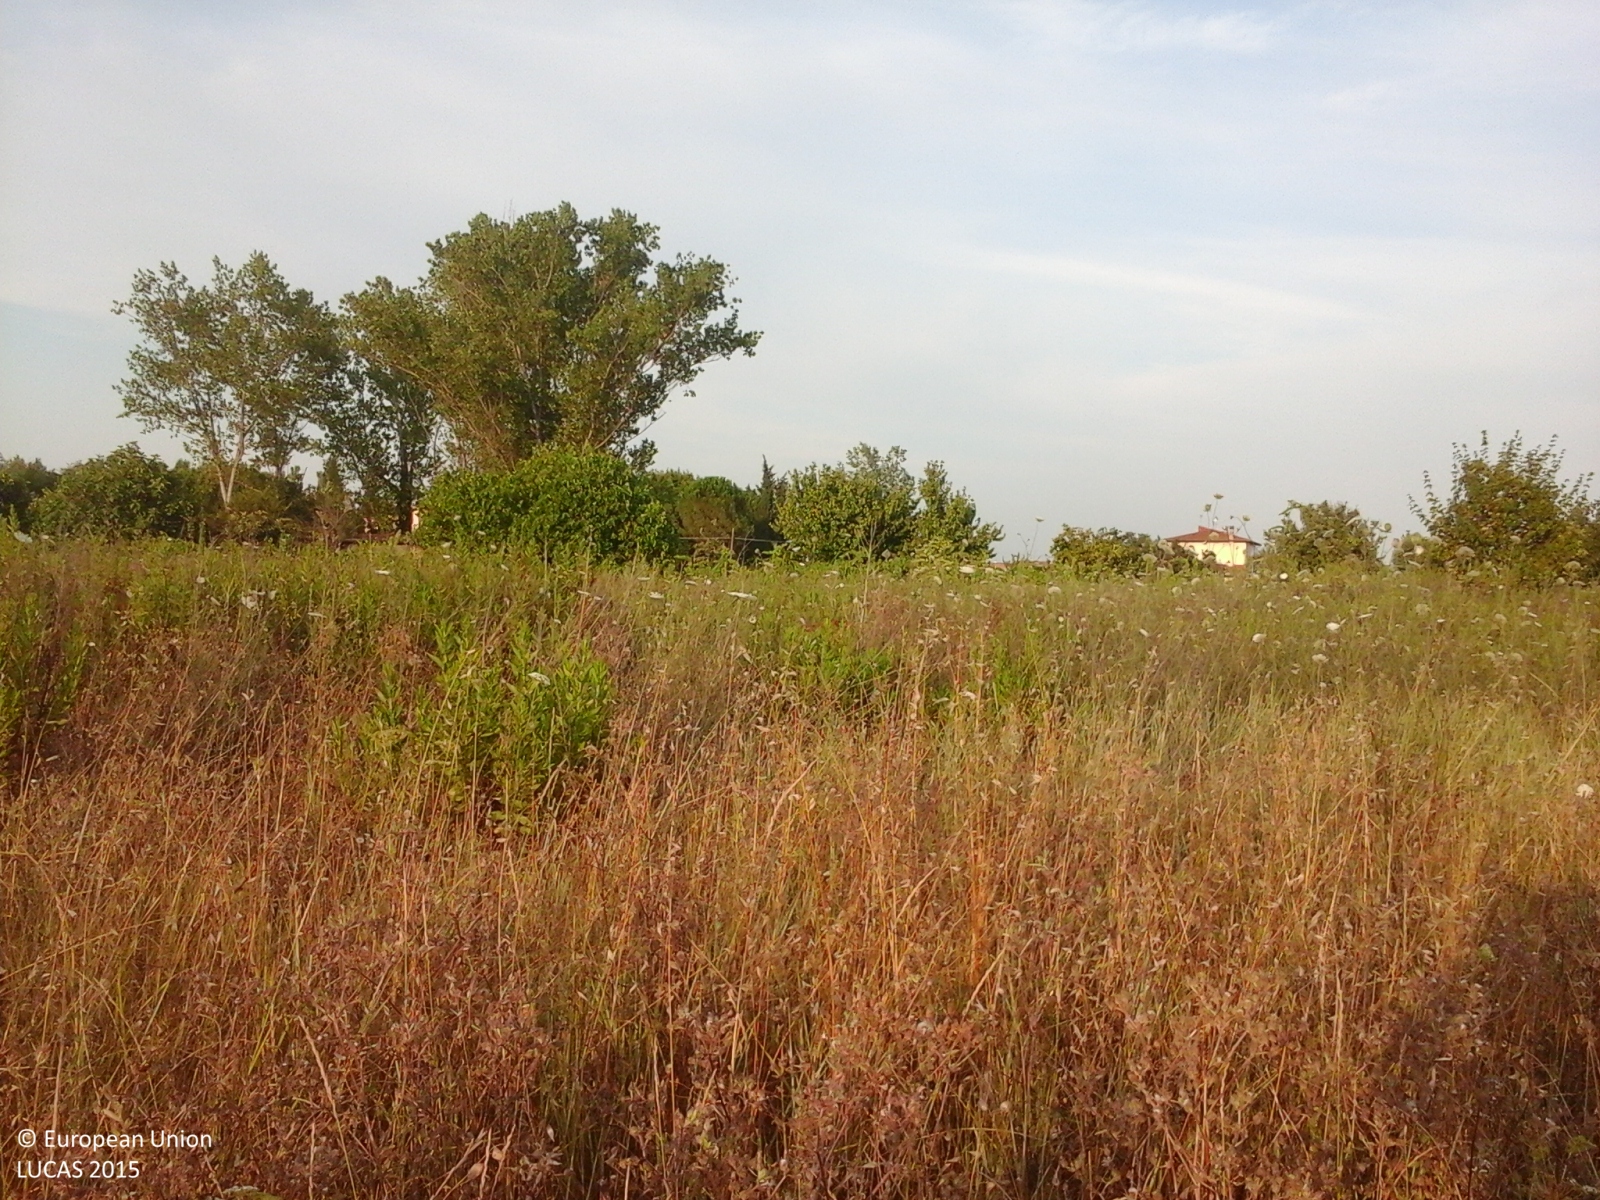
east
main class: Grassland
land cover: Grassland without tree/shrub cover
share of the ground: > 75 %
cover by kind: herbaceous plants 100 %
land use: Agriculture (excluding fallow land and kitchen gardens)
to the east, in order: Grassland without tree/shrub cover; Vineyards; Ditches and canals; Barley; Ditches and canals; Broadleaved woodland; Electric lines; Broadleaved woodland; Paved roads, cycling and walking lanes; Ditches and canals; Grassland without tree/shrub cover; Electric lines; Grassland without tree/shrub cover; Abandoned hedges; Paved roads, cycling and walking lanes; Grass margins; Ditches and canals; Grassland without tree/shrub cover
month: July
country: IT
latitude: 43.7149
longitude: 10.9284
